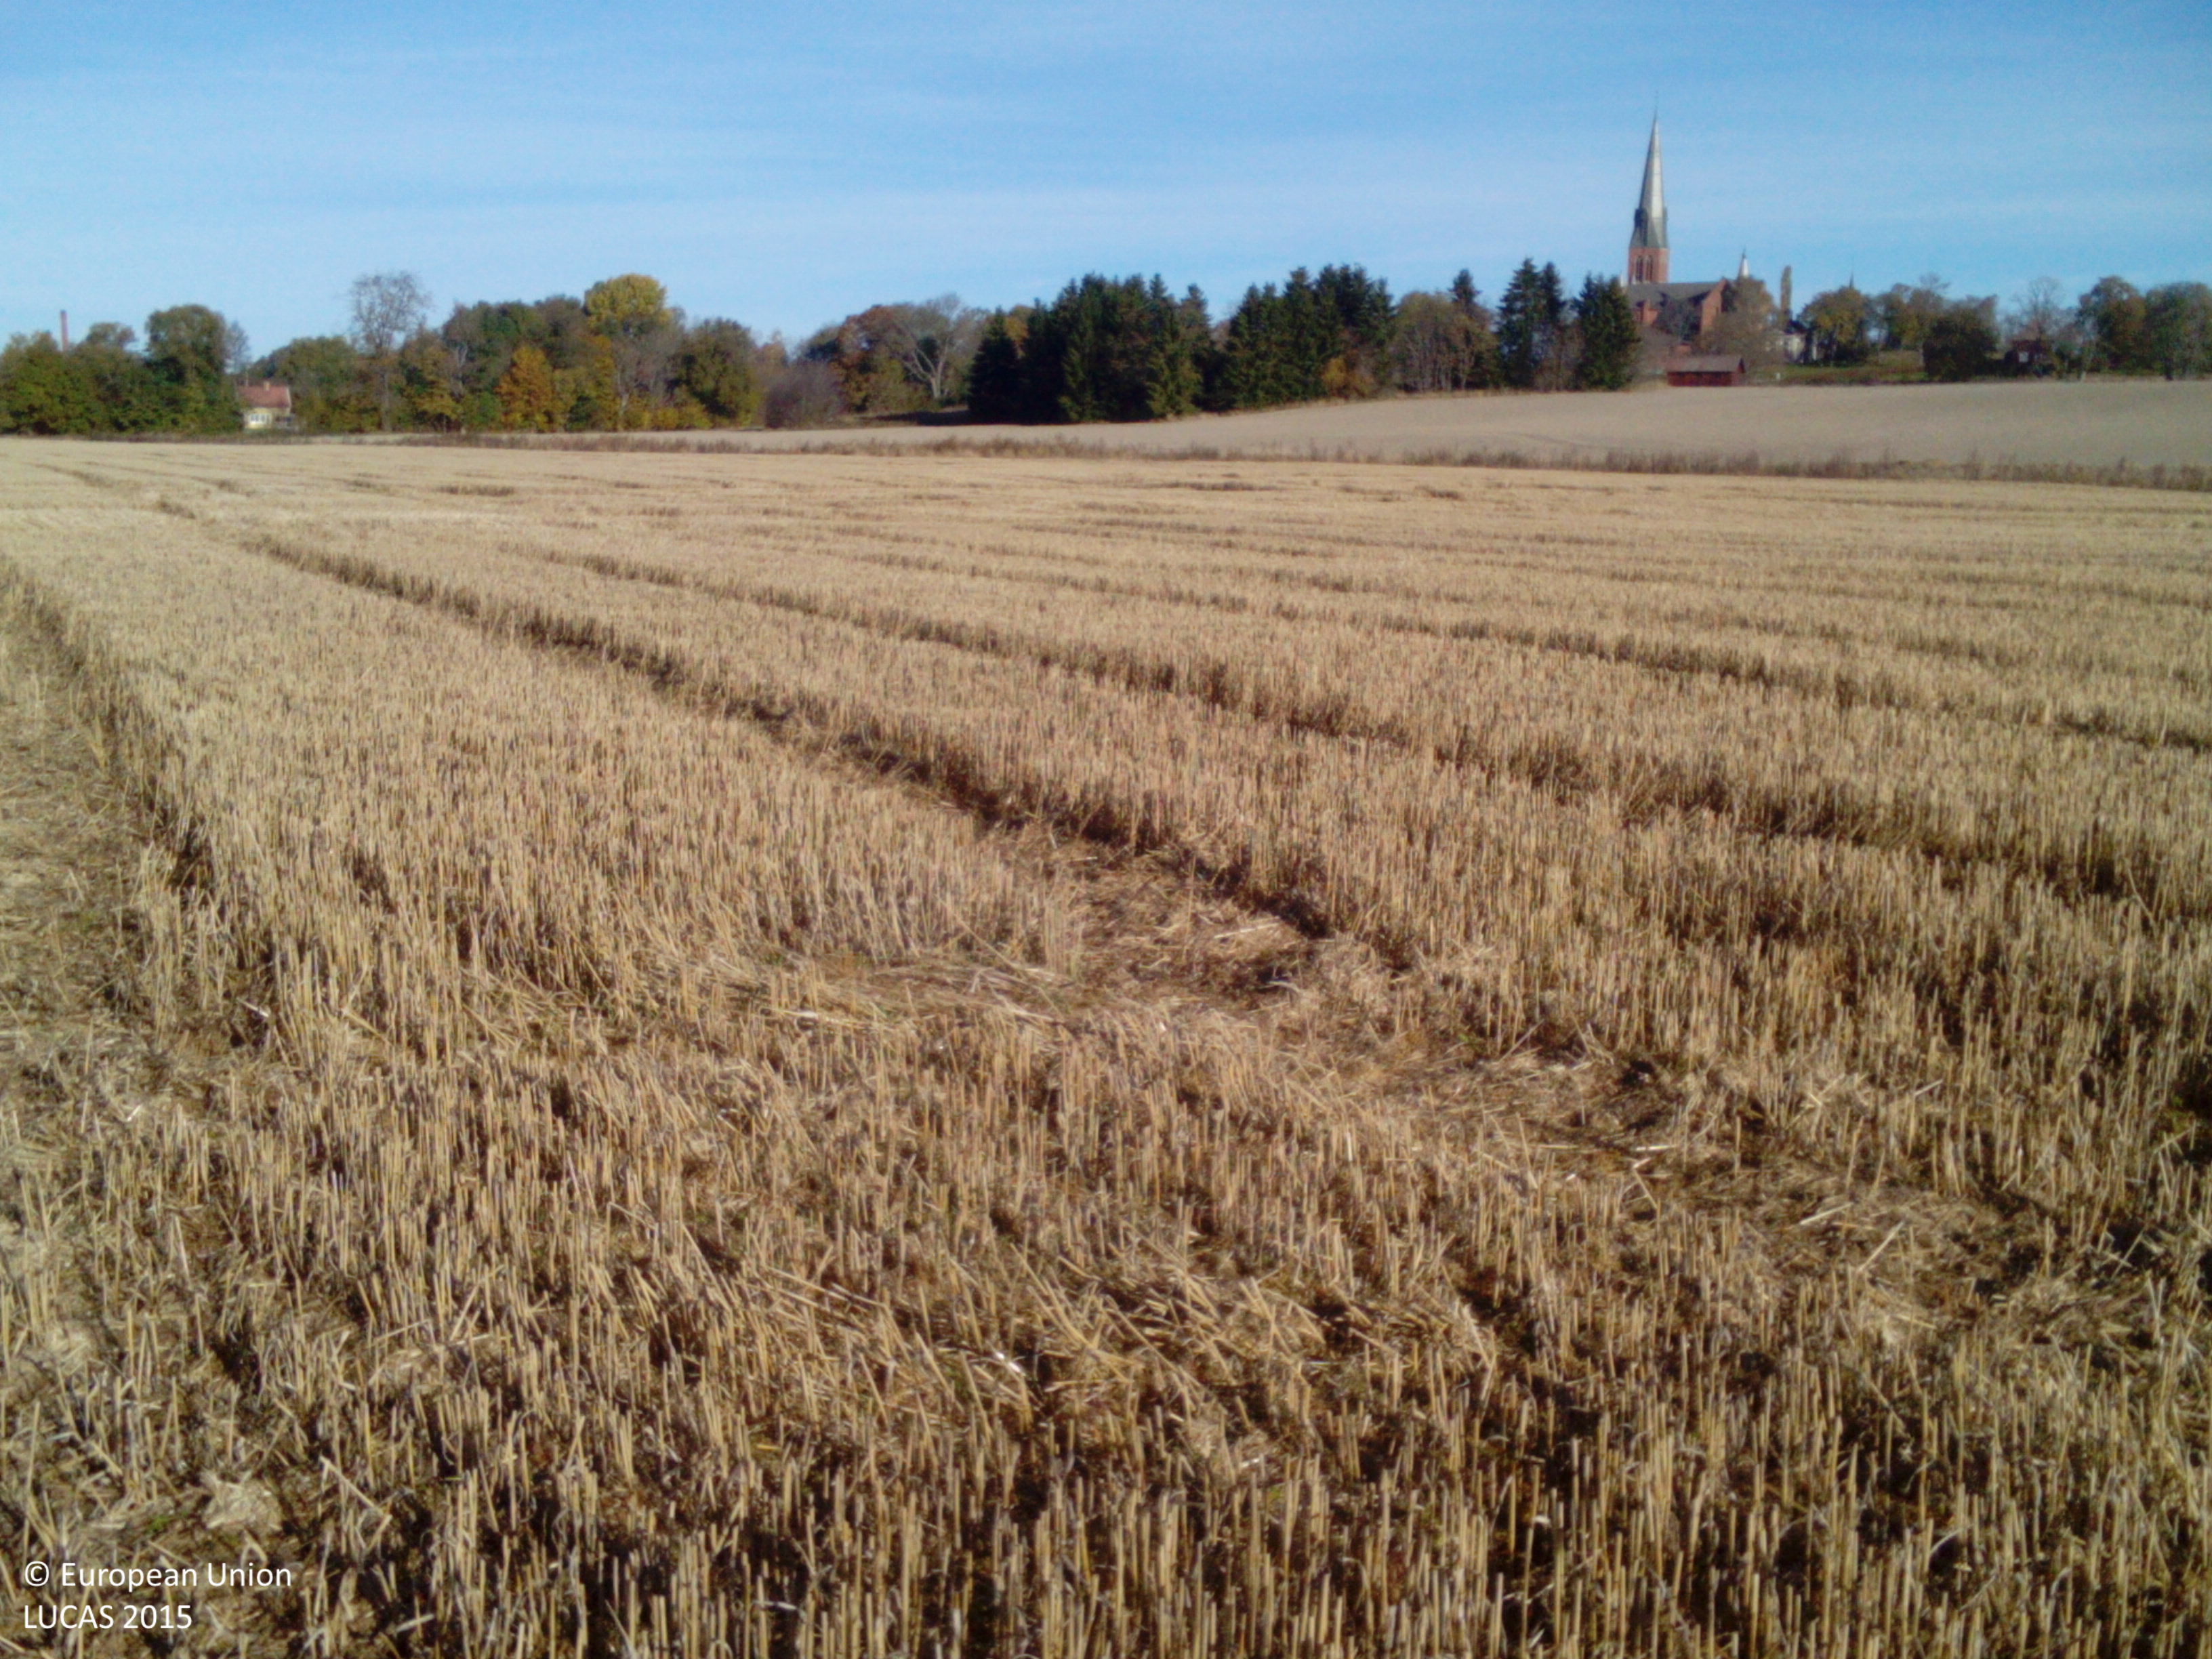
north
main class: Cropland
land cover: Common wheat
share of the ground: > 75 %
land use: Agriculture (excluding fallow land and kitchen gardens)
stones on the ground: < 10 %
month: October
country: SE
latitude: 59.0620
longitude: 16.3590
